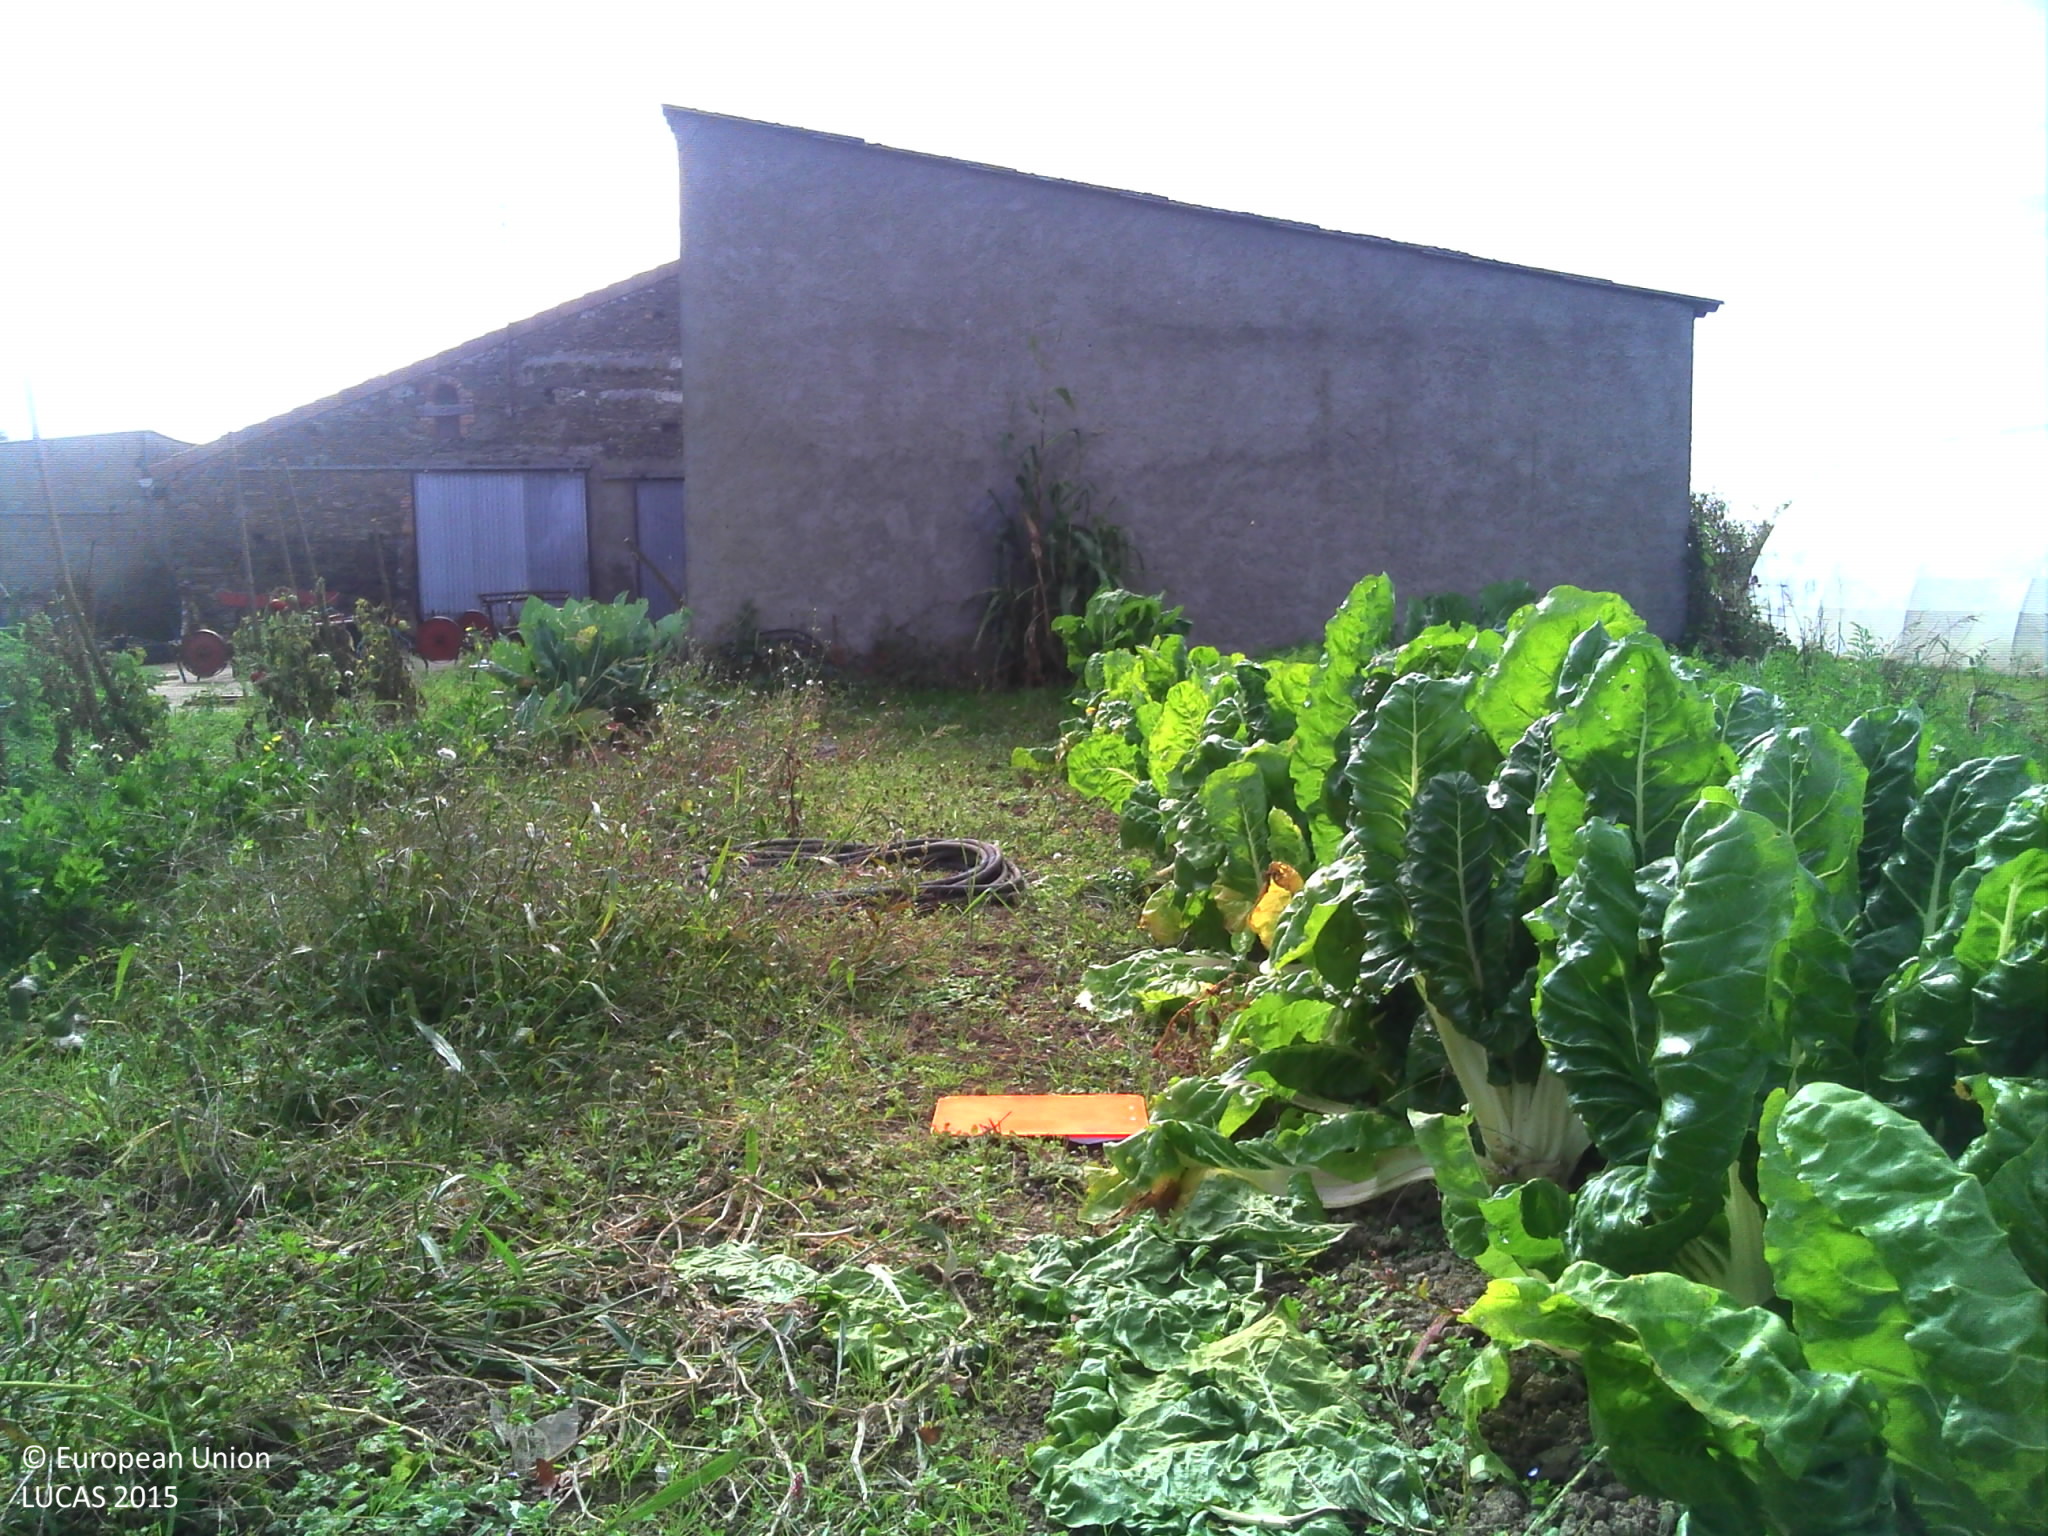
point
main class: Cropland
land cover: Other root crops
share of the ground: > 75 %
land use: Kitchen garden
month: October
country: FR
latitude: 47.1124
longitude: -0.9596
